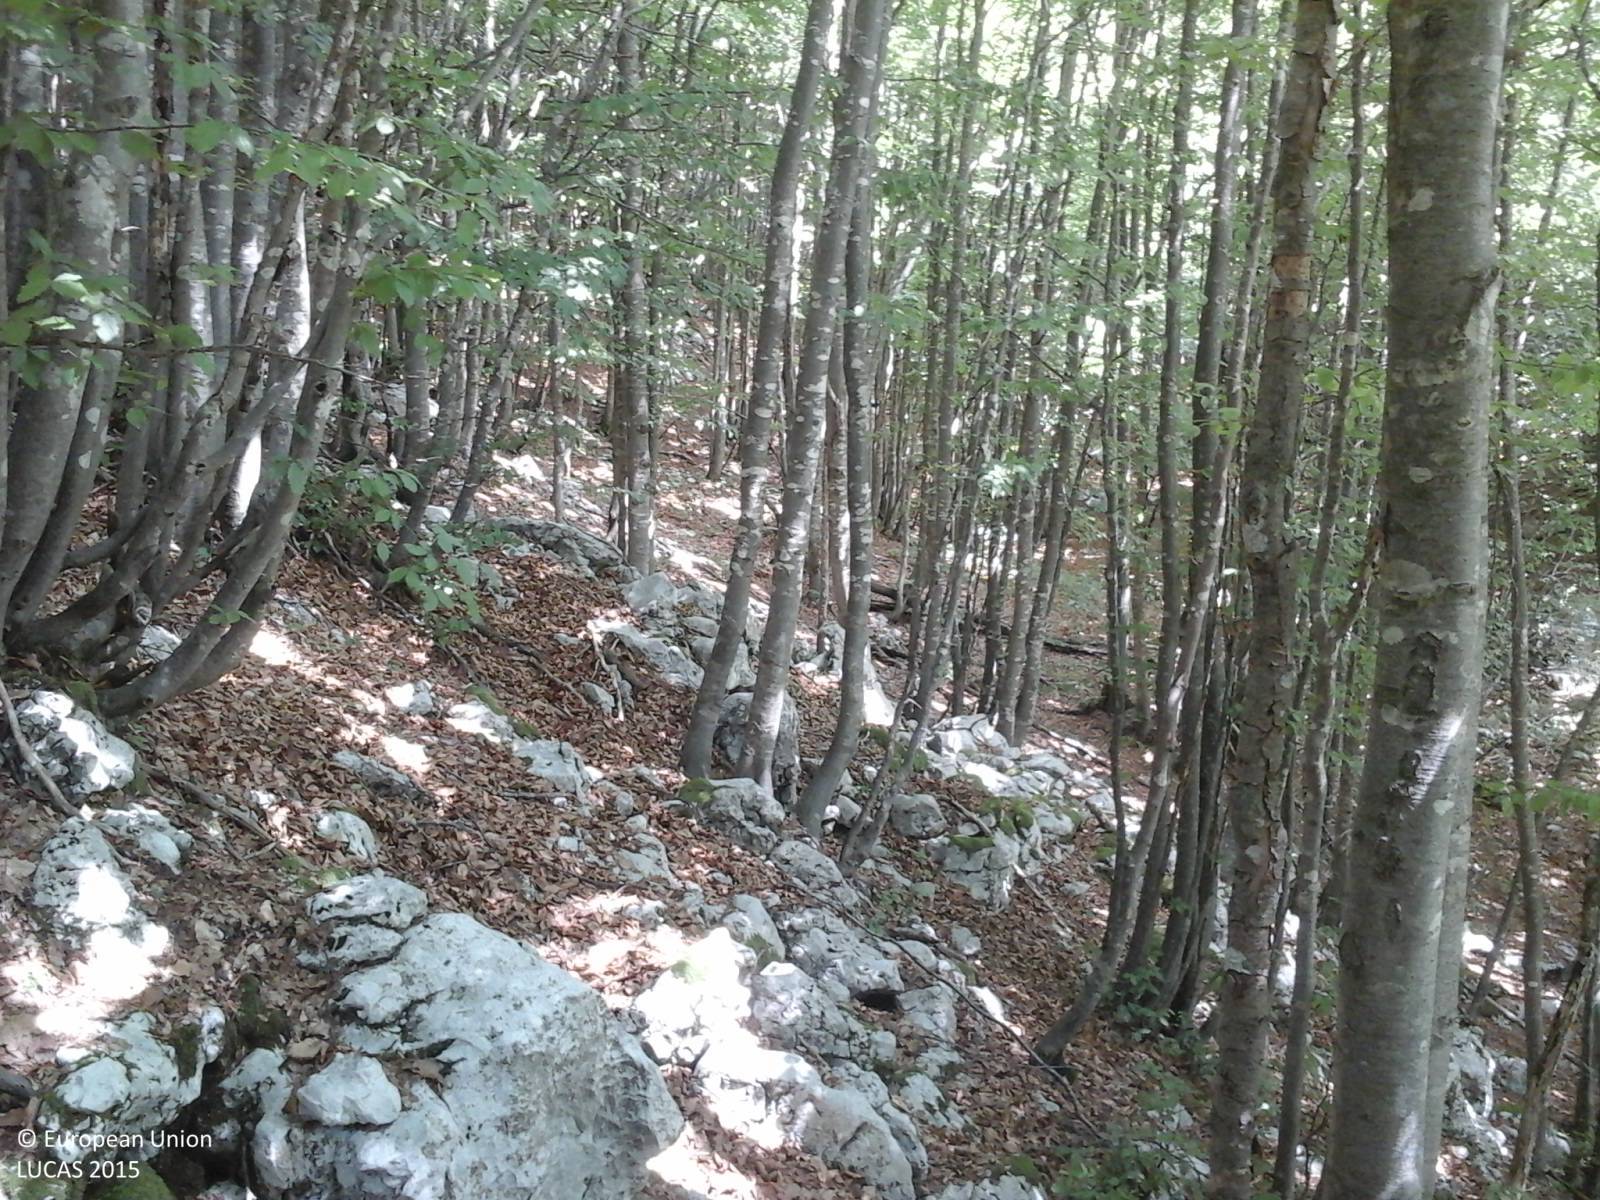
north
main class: Woodland
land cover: Broadleaved woodland
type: mountainous beech forest
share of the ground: > 75 %
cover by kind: broadleaved forest trees 100 %
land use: Forestry
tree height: > 5 m
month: July
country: IT
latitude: 46.1227
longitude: 12.5463
